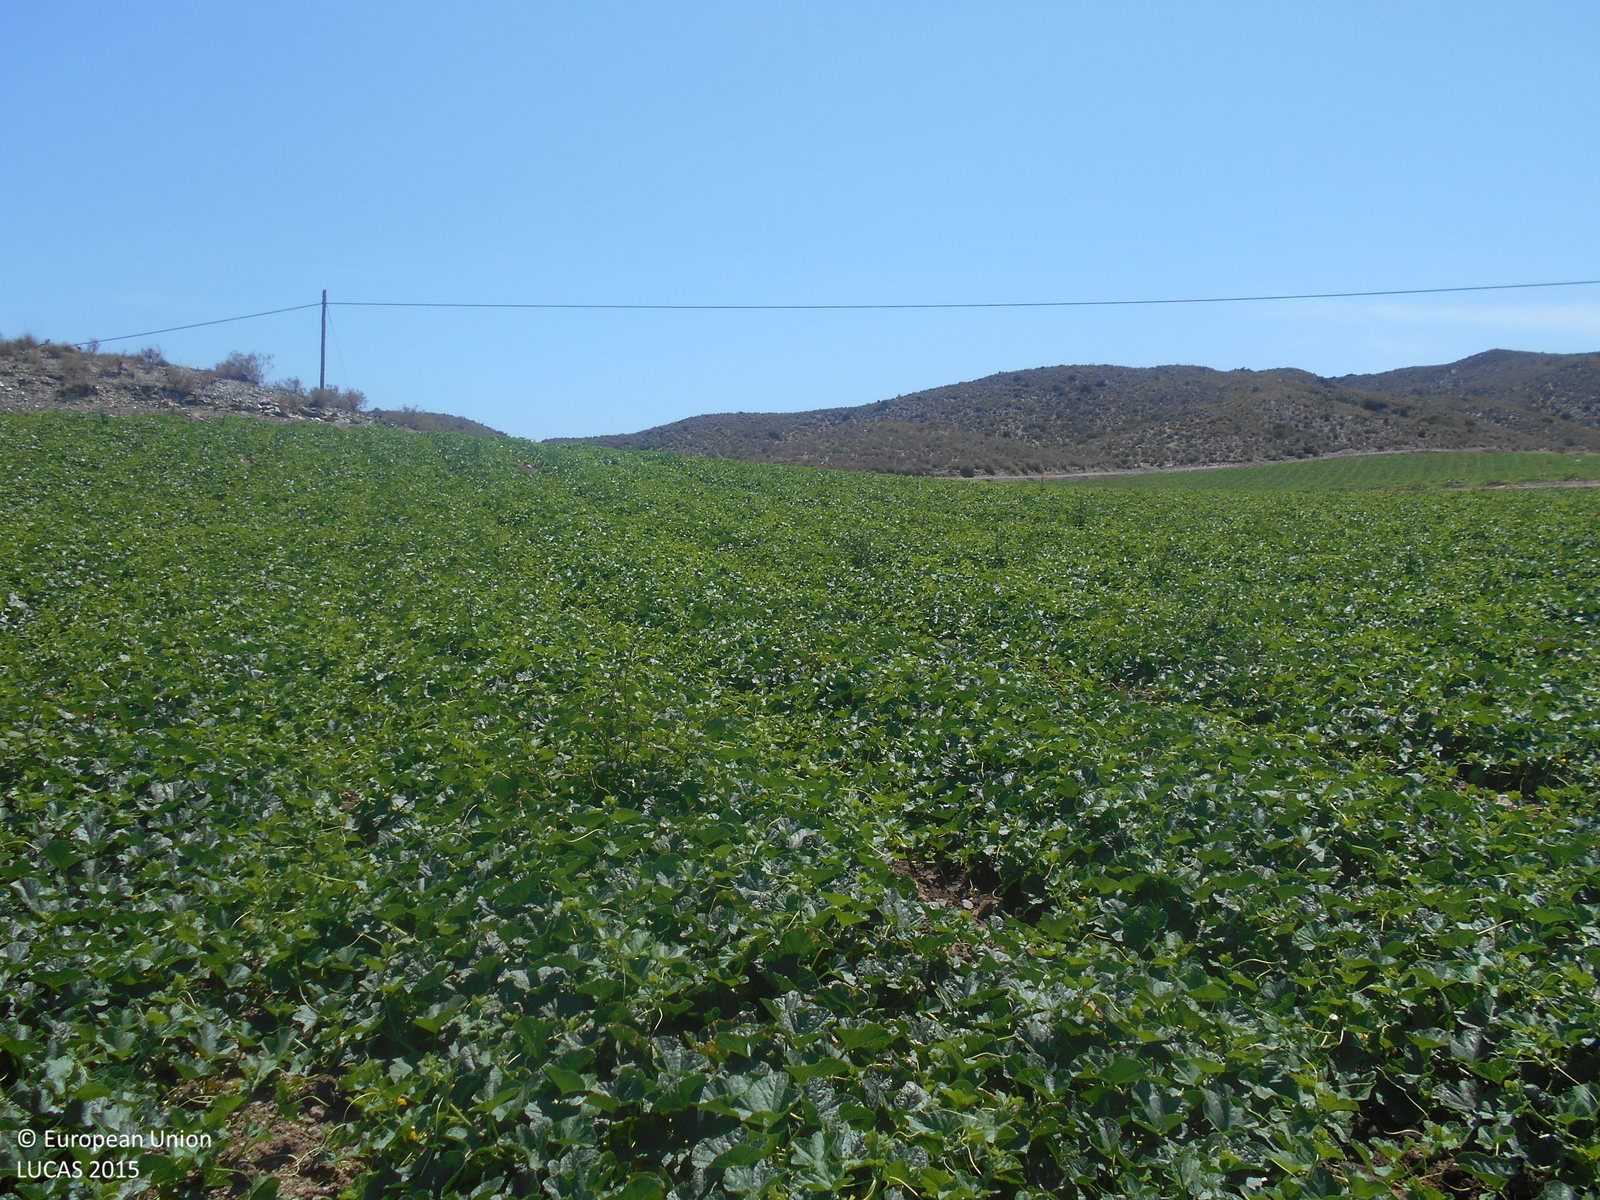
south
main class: Cropland
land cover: Other fresh vegetables
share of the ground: > 75 %
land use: Agriculture (excluding fallow land and kitchen gardens)
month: May
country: ES
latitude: 37.5150
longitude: -1.4174
